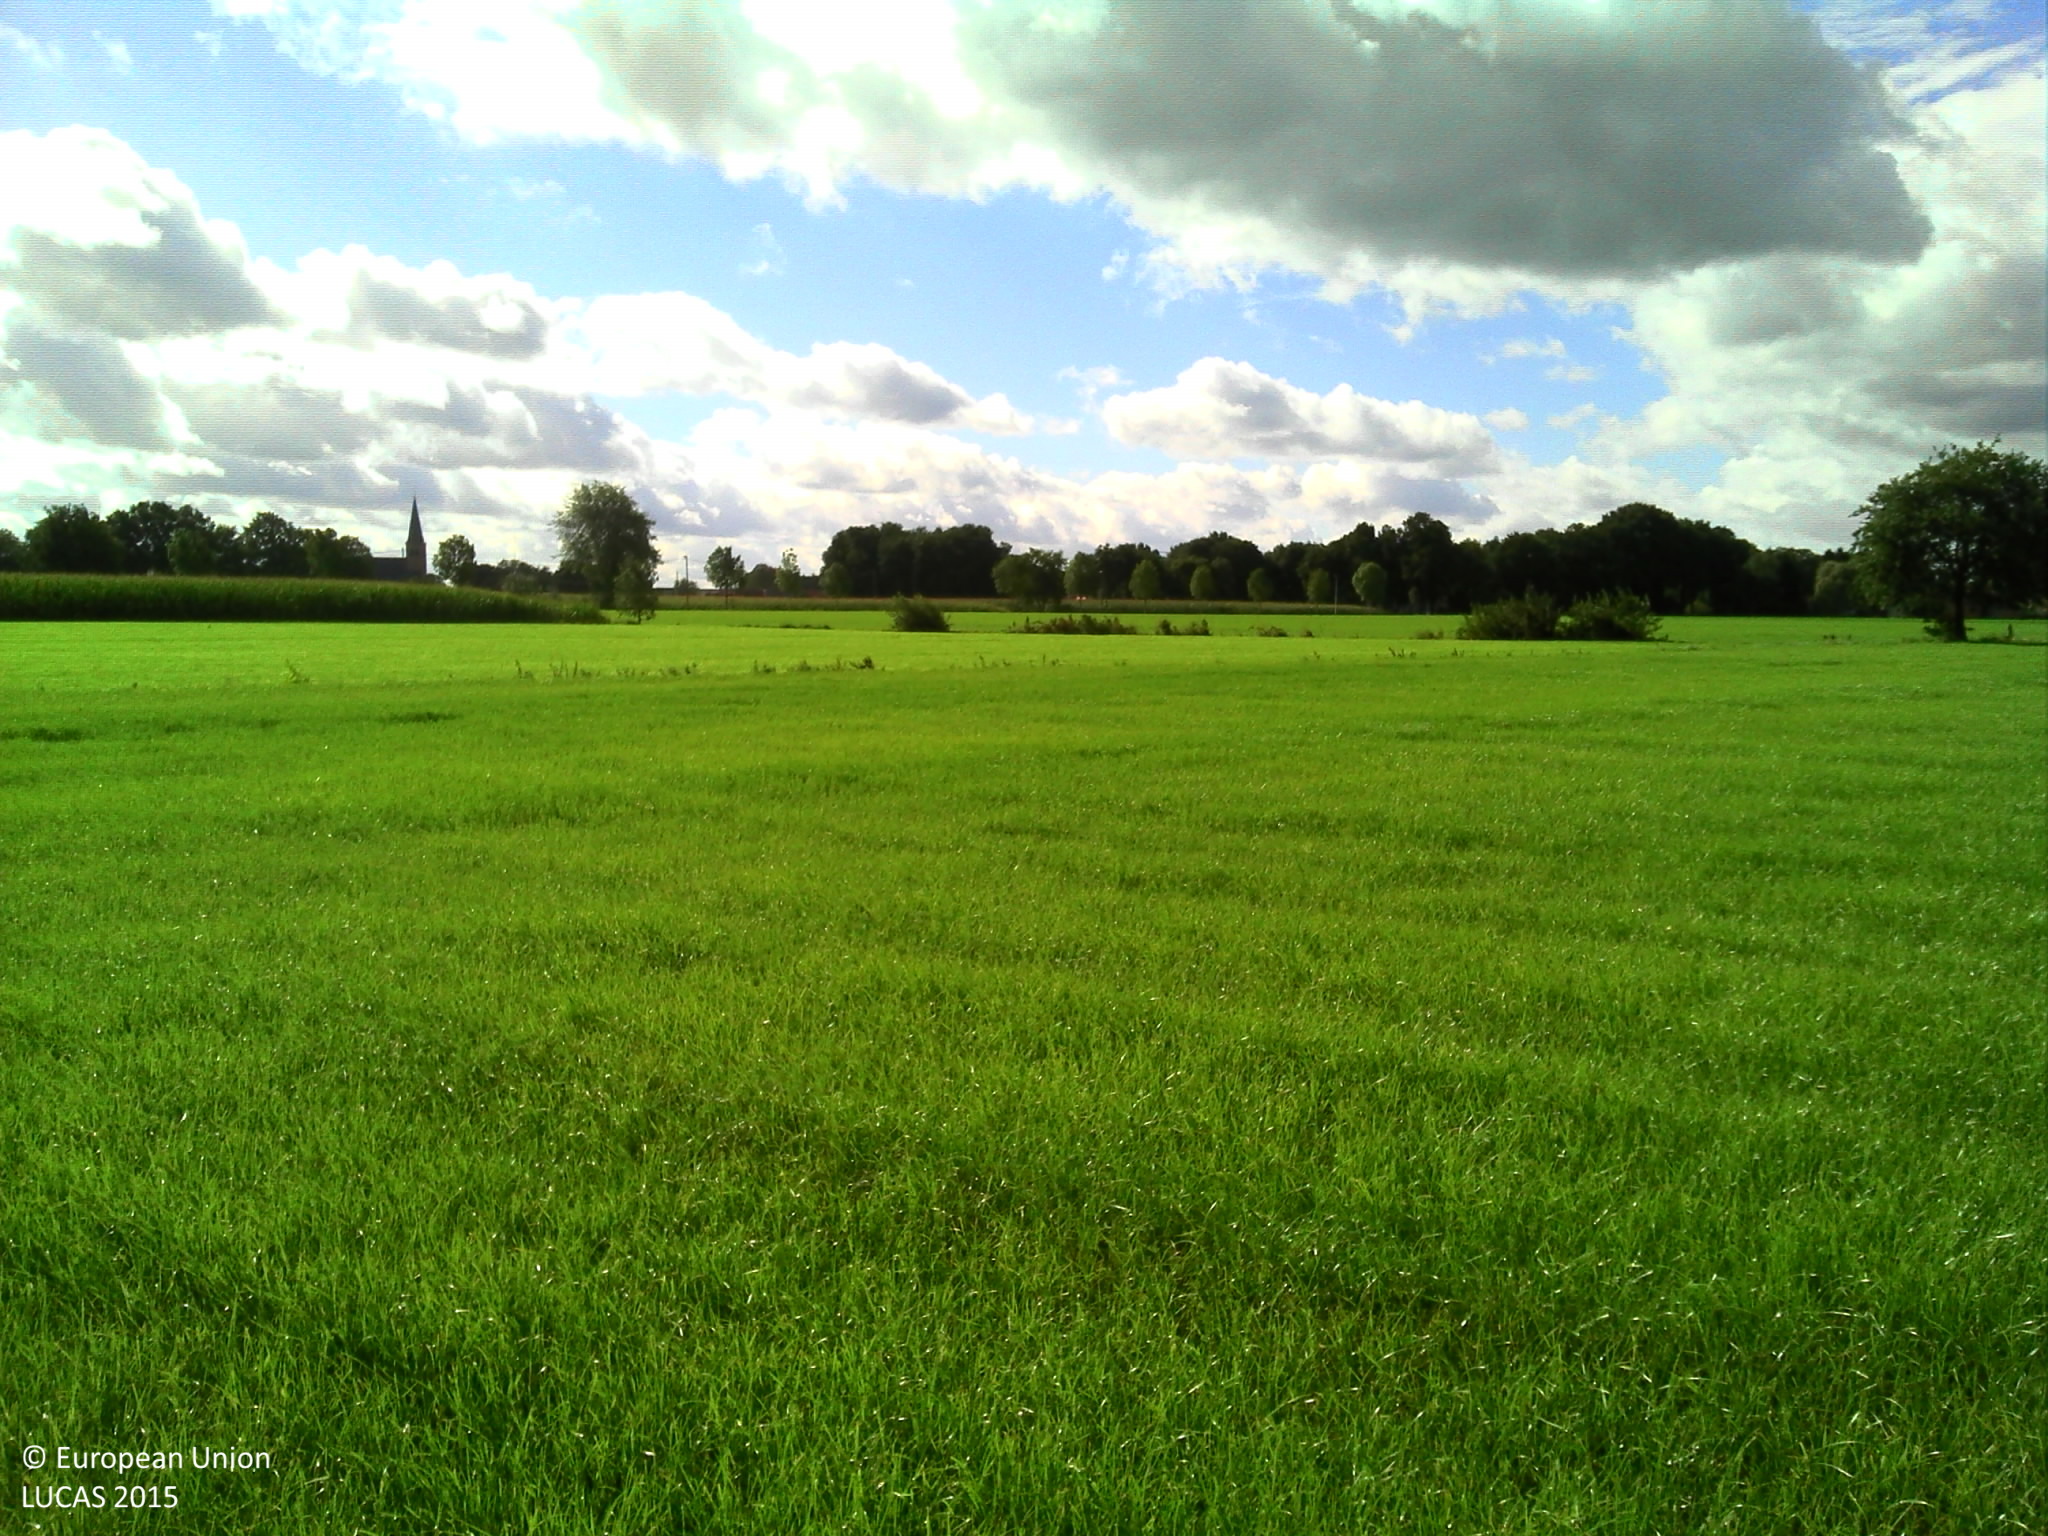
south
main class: Cropland
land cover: Temporary grasslands
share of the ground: > 75 %
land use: Agriculture (excluding fallow land and kitchen gardens)
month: September
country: BE
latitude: 51.4399
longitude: 4.5145
